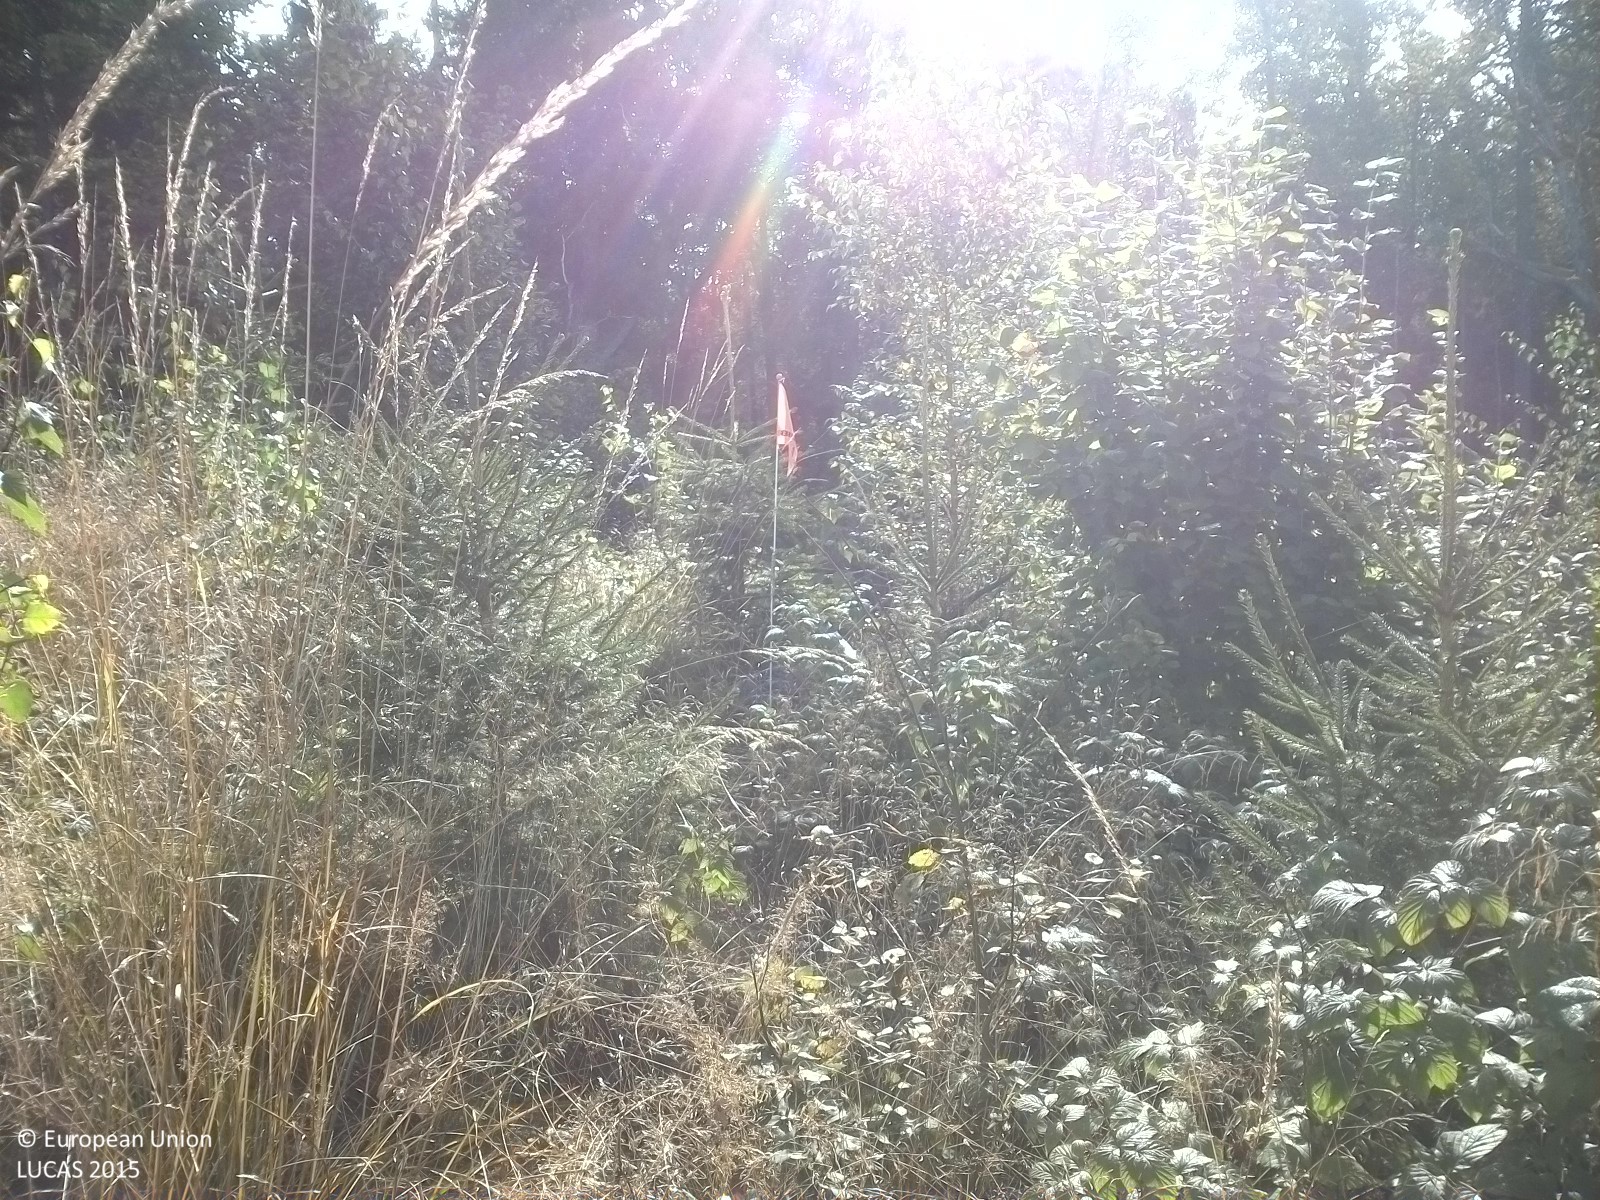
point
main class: Woodland
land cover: Spruce dominated mixed woodland
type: boreal forest
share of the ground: 25 - 50 %
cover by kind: herbaceous plants 40 %, coniferous forest trees 20 %, broadleaved forest trees 20 %, shrubs 10 %, lichens and mosses 10 %
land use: Forestry
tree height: < 5 m
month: September
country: SE
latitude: 59.0371
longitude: 15.6912
